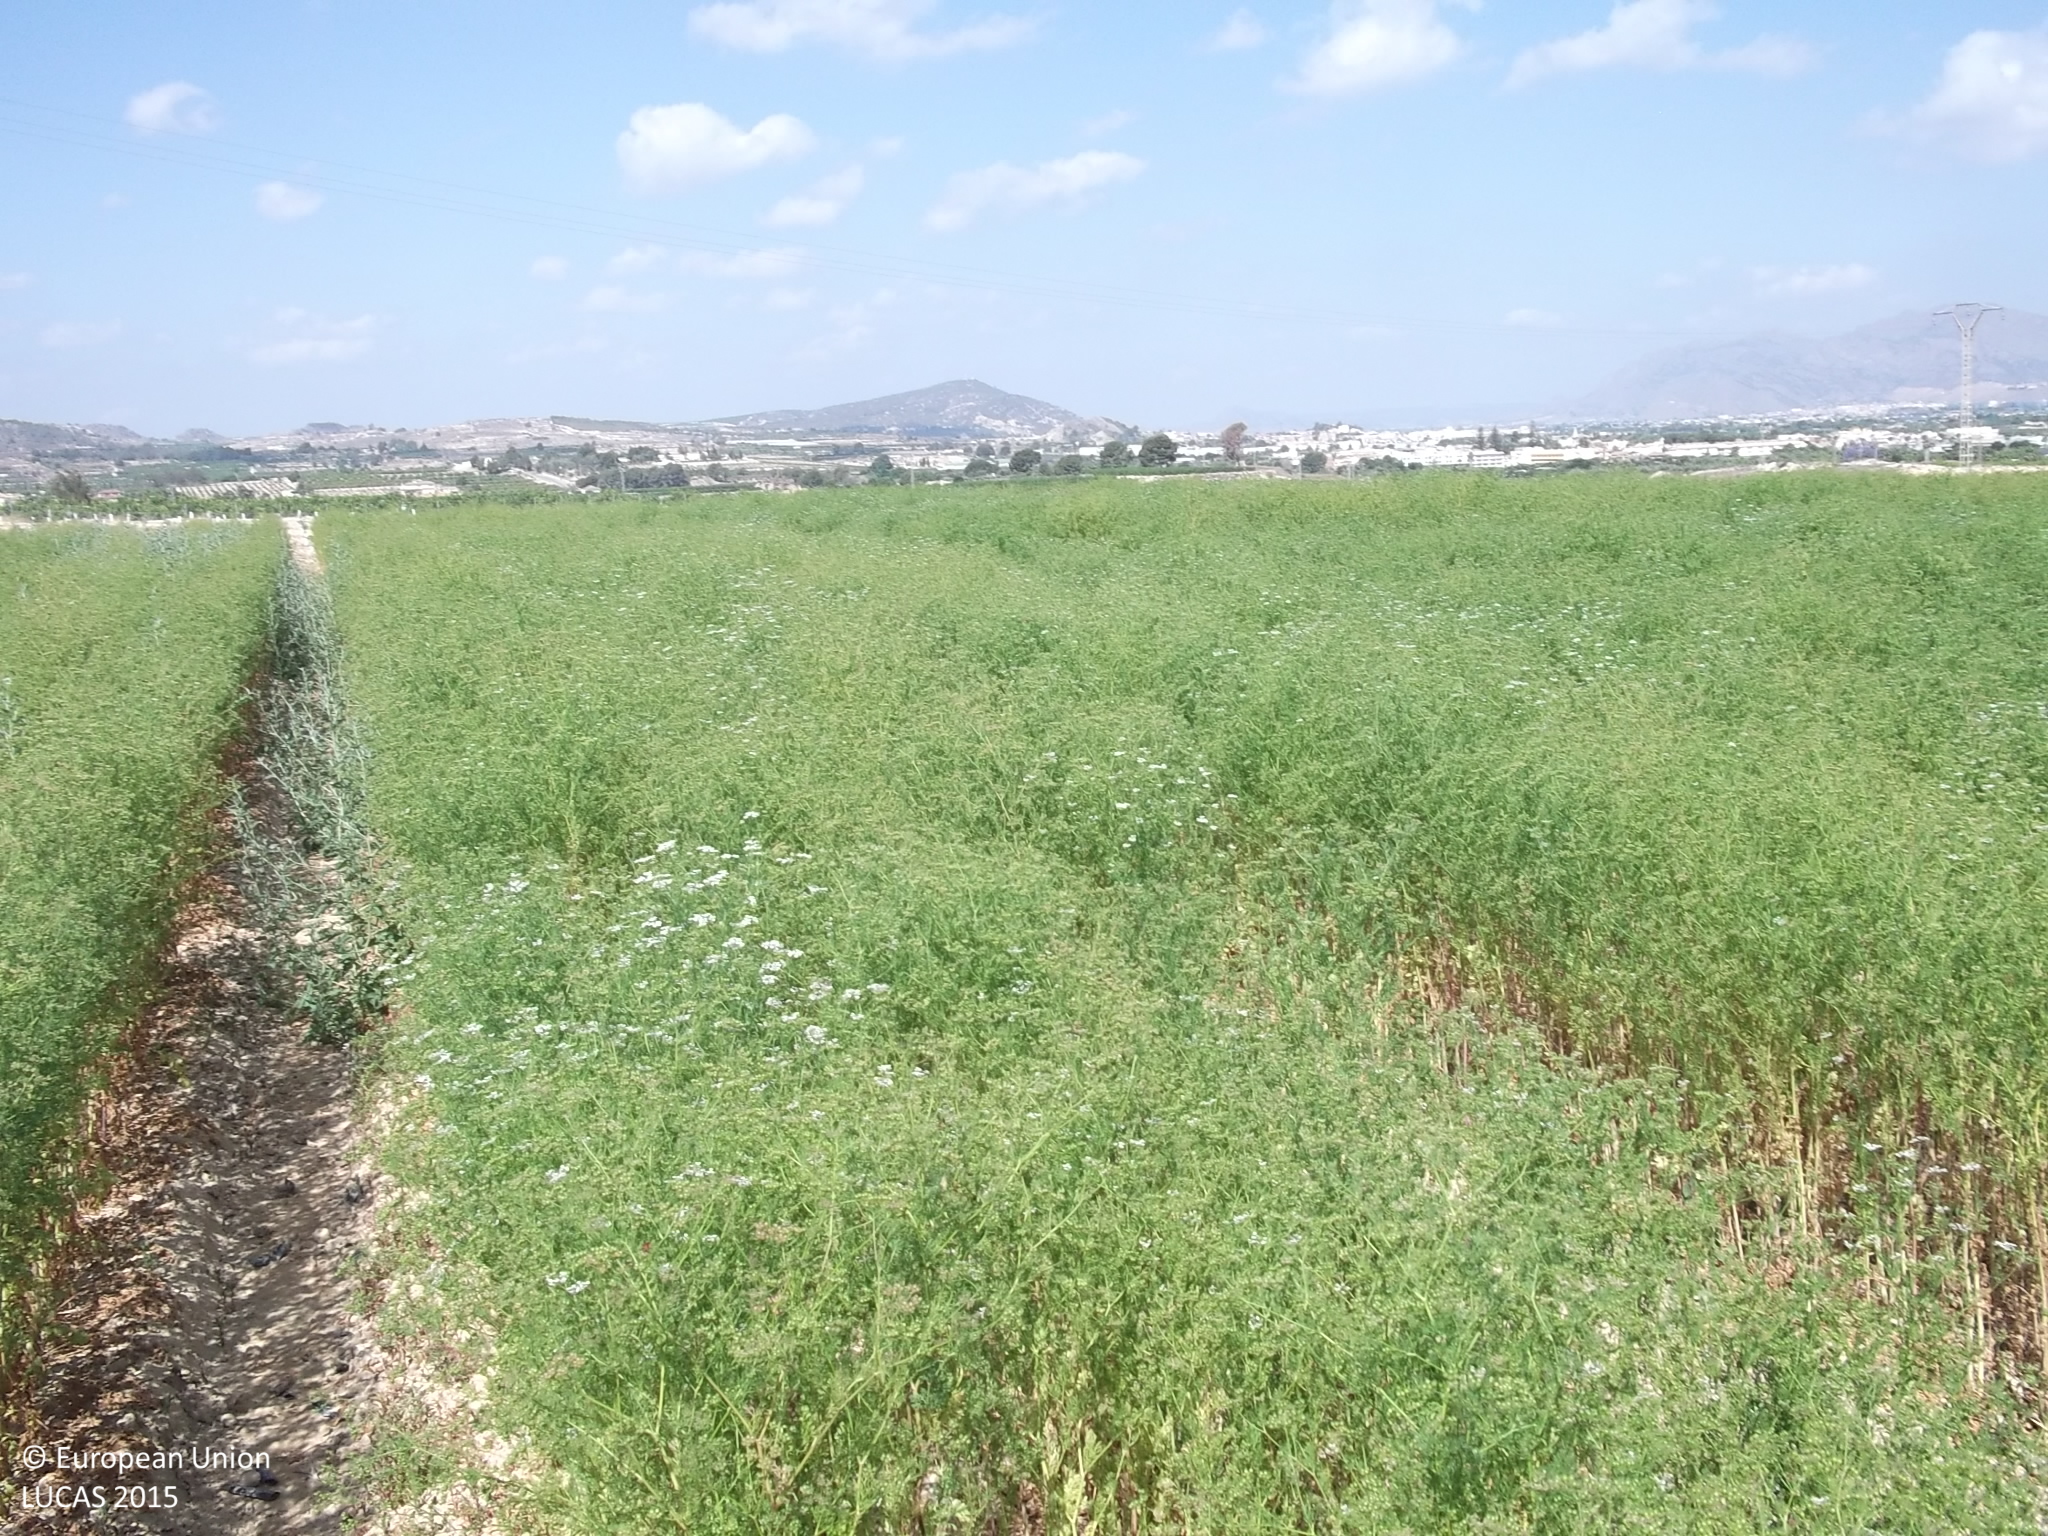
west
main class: Cropland
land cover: Other non-permanent industrial crops
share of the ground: > 75 %
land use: Agriculture (excluding fallow land and kitchen gardens)
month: May
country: ES
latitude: 38.0577
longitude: -0.8447
